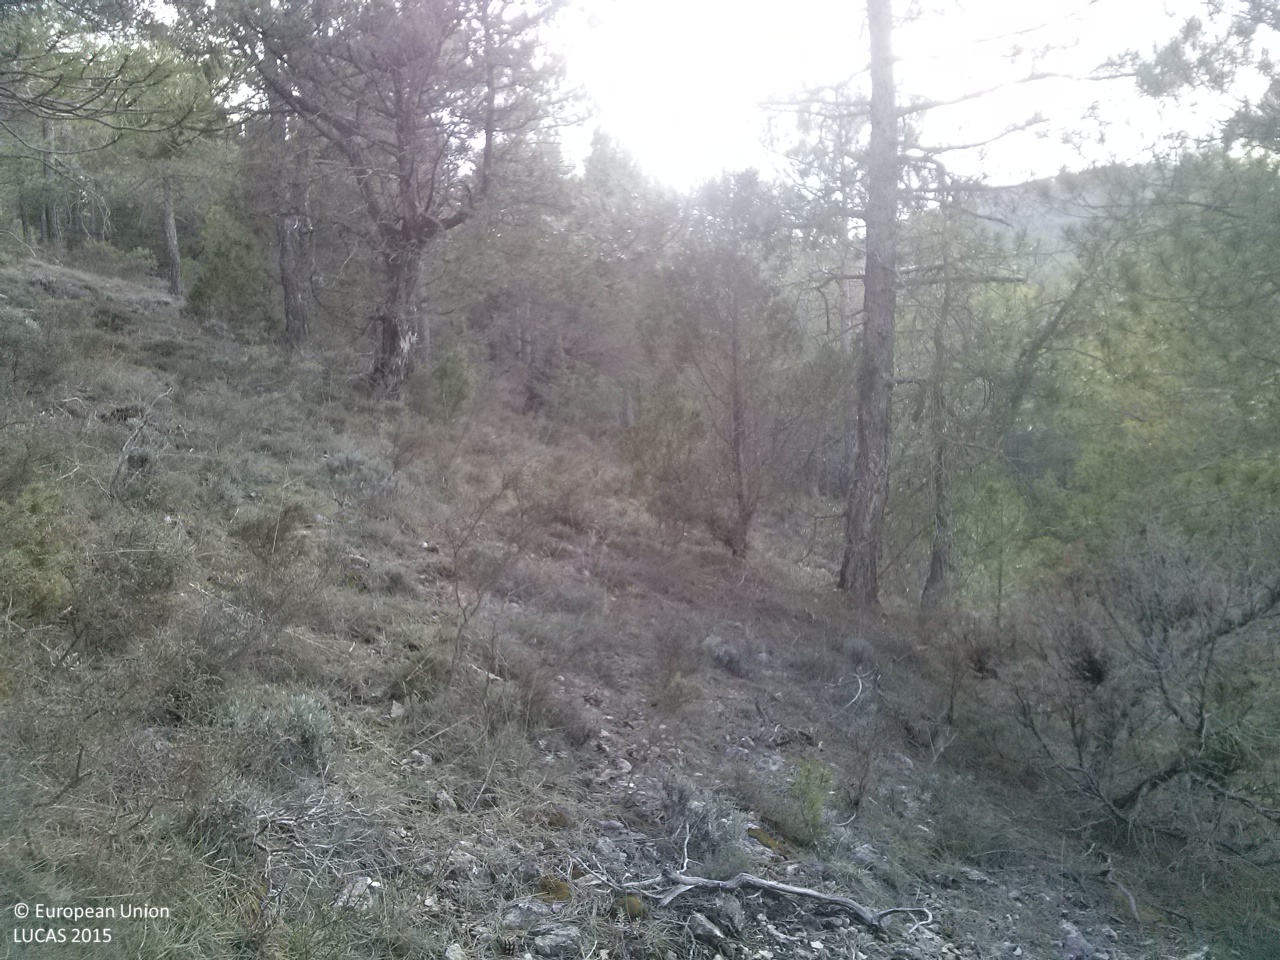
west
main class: Woodland
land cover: Pine dominated coniferous woodland
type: coniferous forest of the mediterranean region
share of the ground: 50 - 75 %
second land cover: Grassland without tree/shrub cover
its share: 50 - 75 %
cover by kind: coniferous forest trees 50 %, herbaceous plants 30 %, unconsolidated bare surface 15 %, shrubs 5 %
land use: Forestry
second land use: Agriculture (excluding fallow land and kitchen gardens)
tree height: > 5 m
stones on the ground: 10 - 25 %
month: April
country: ES
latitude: 40.1114
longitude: -1.7098
